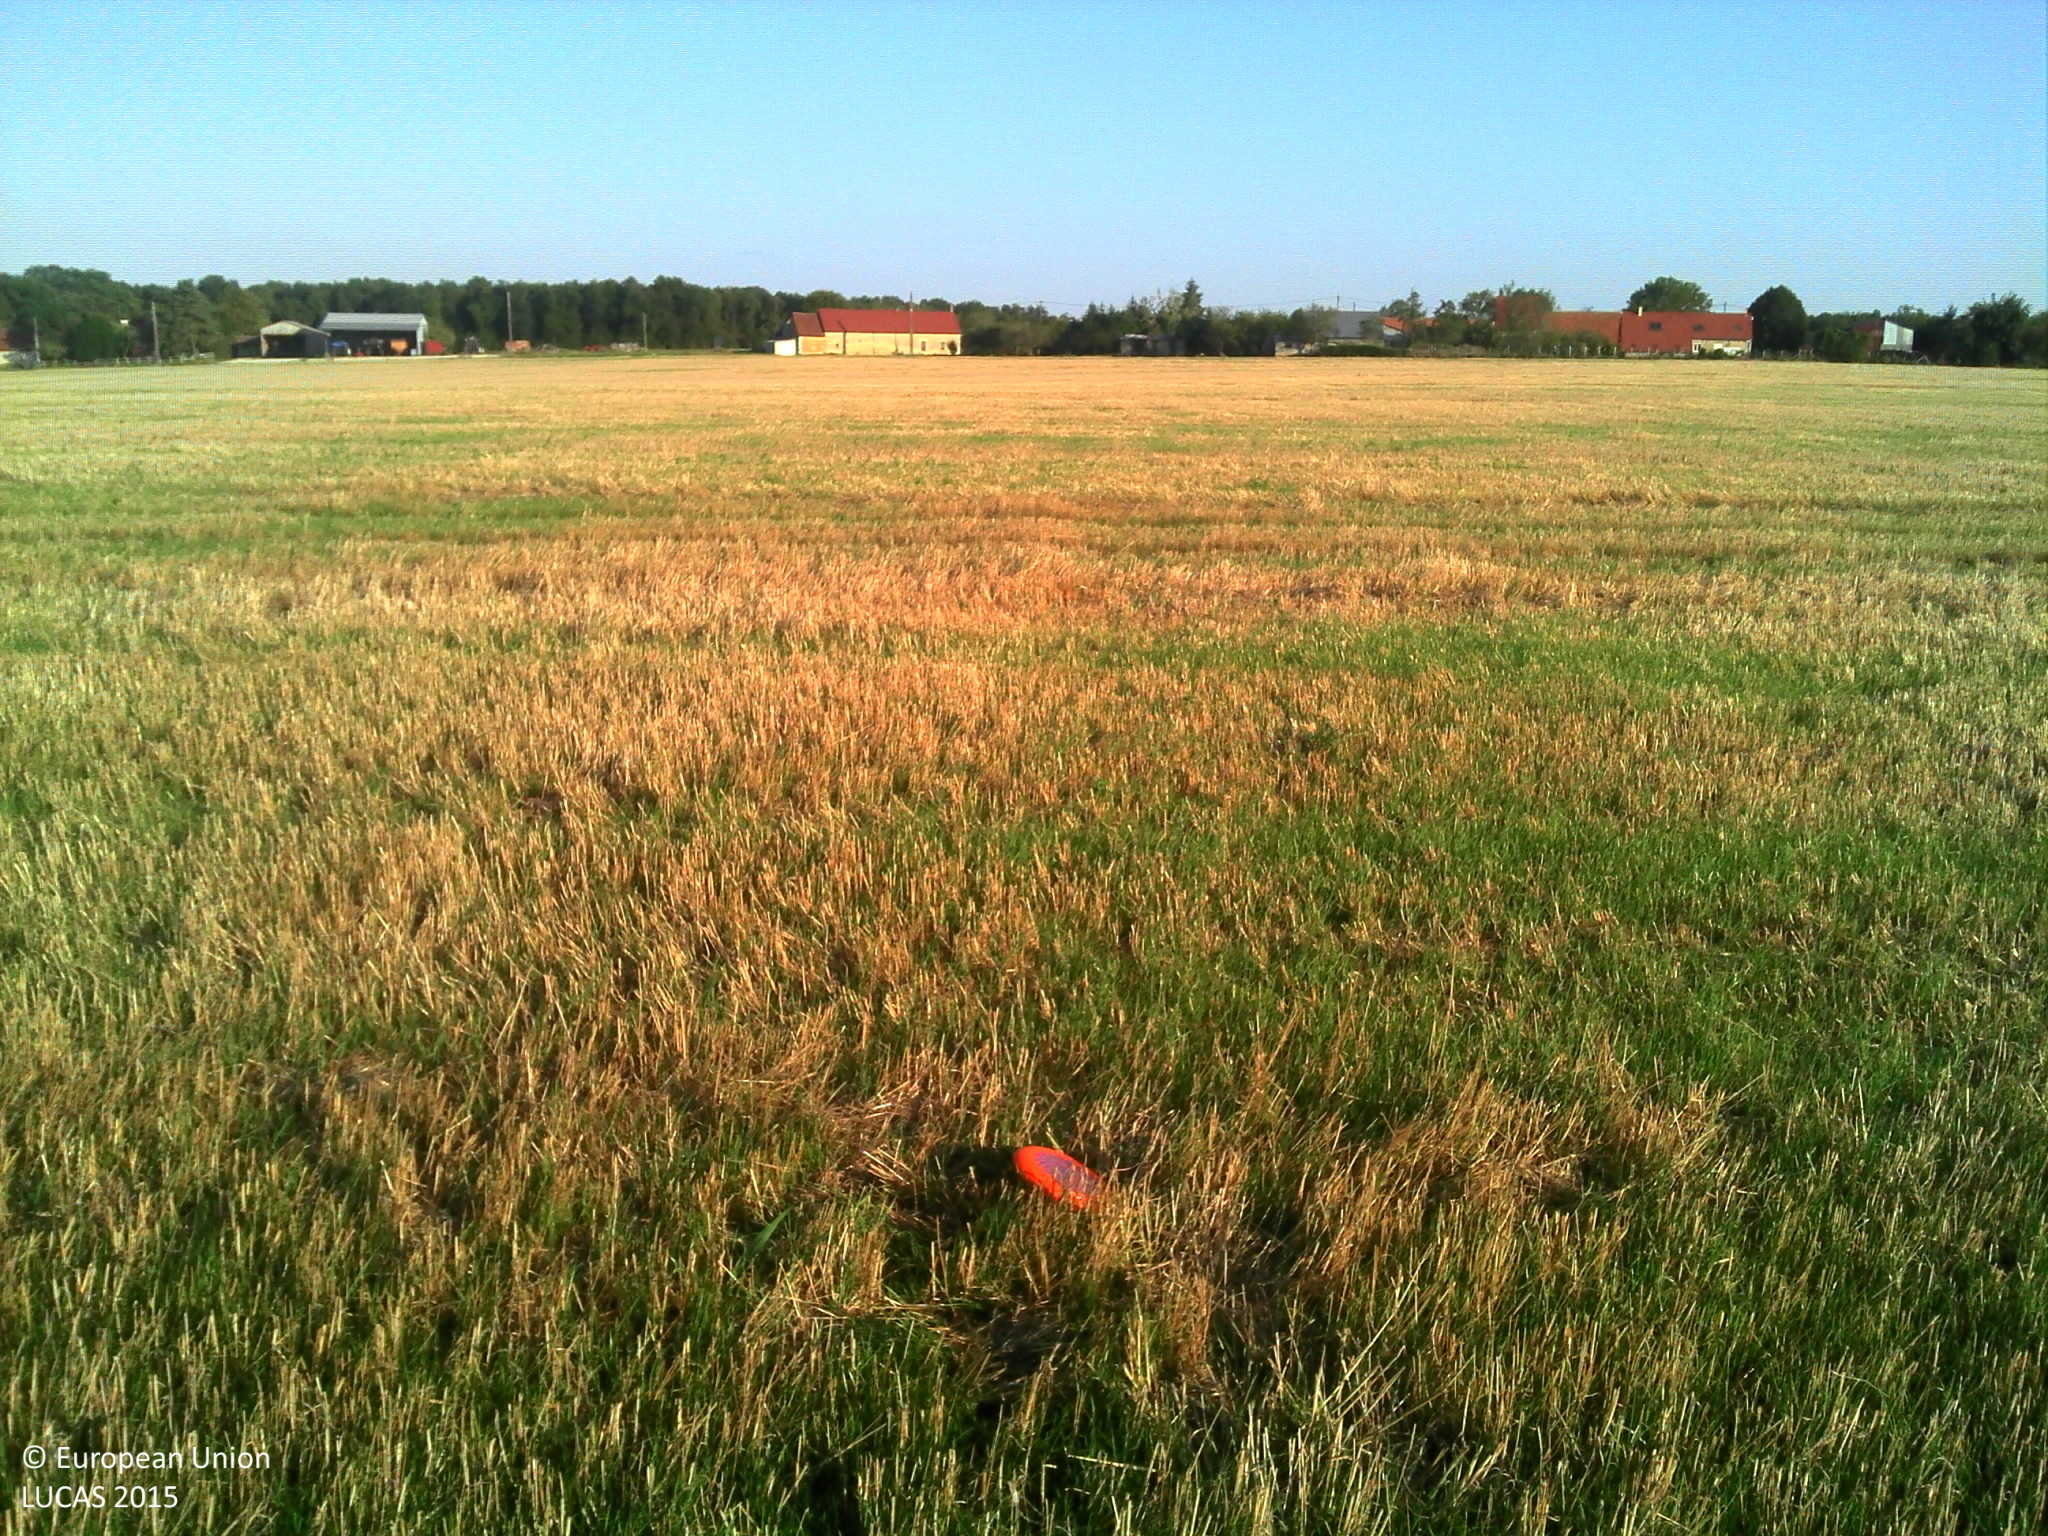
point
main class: Cropland
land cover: Common wheat
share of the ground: > 75 %
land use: Agriculture (excluding fallow land and kitchen gardens)
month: September
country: FR
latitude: 47.0284
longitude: 1.5273
